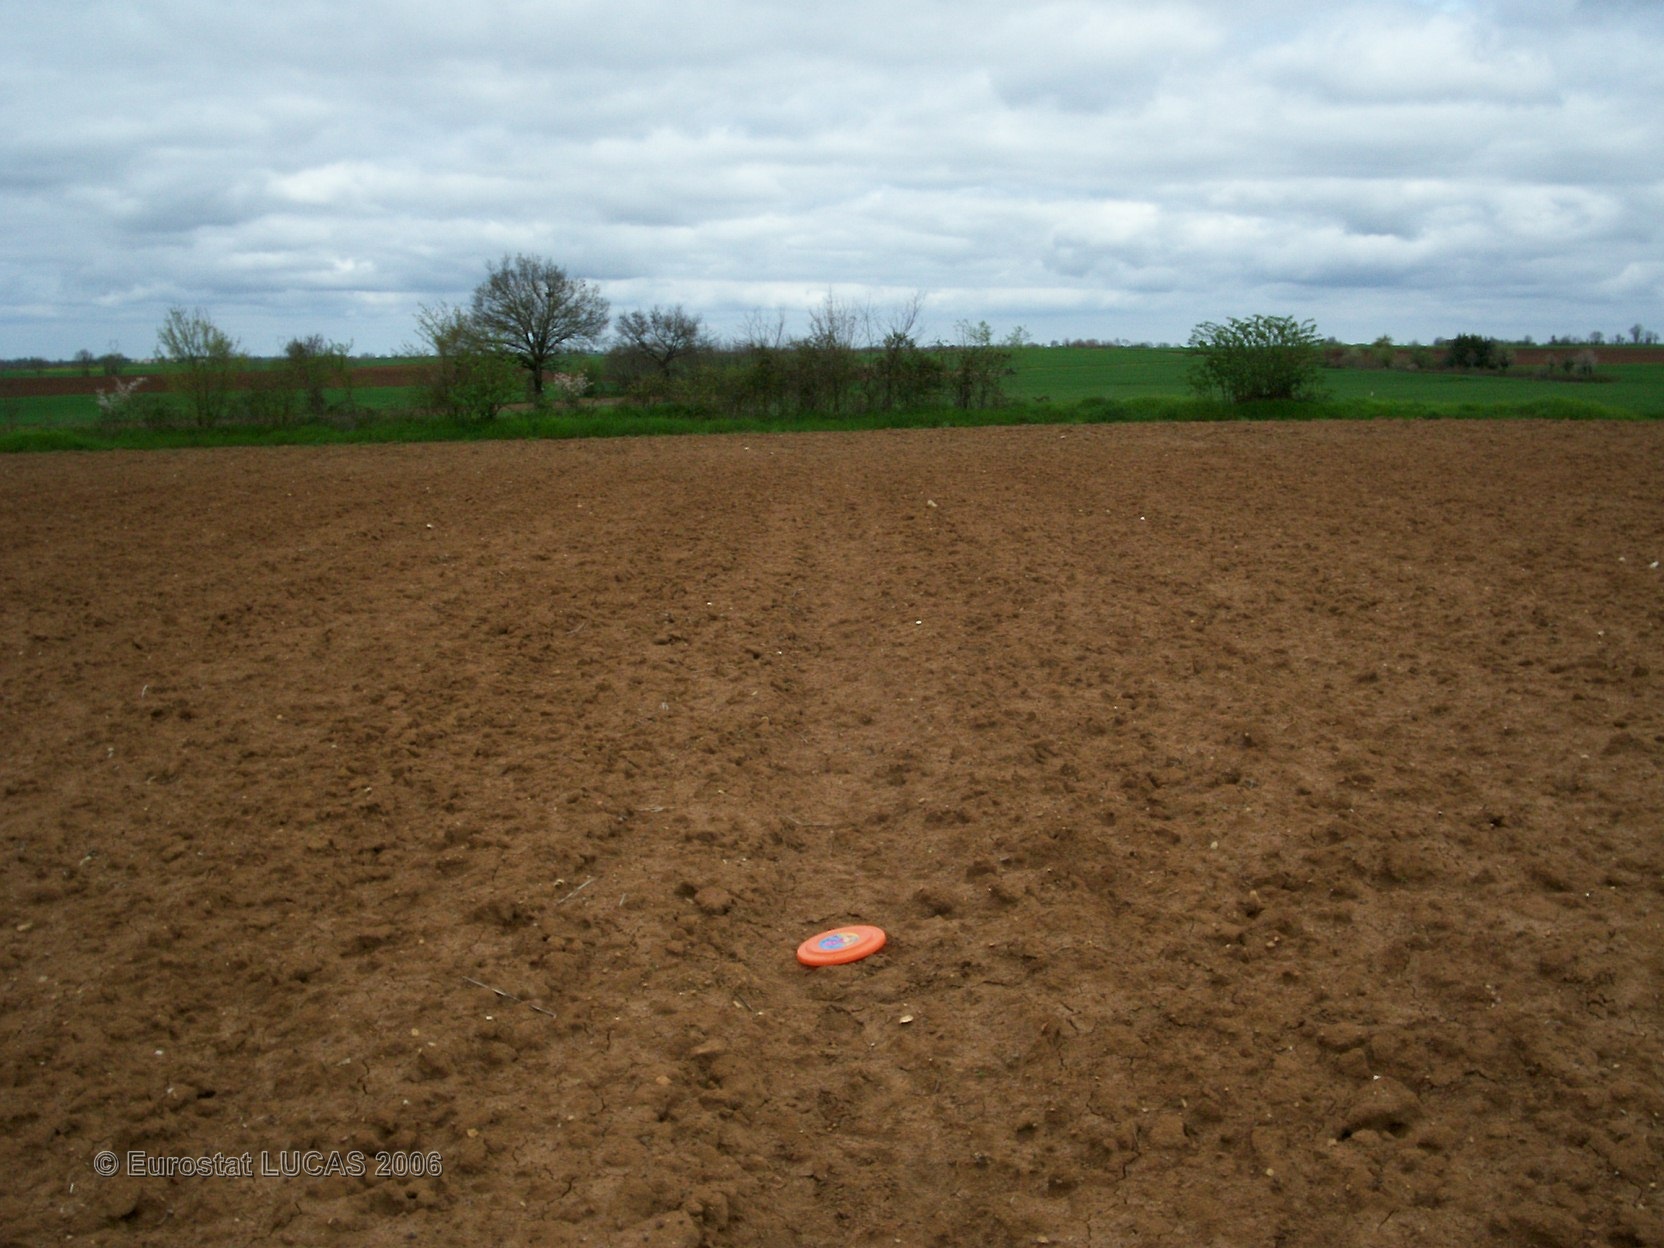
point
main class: Cropland
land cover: Maize
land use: Agriculture (excluding fallow land and kitchen gardens)
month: May
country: FR
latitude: 46.2916
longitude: -0.2651
